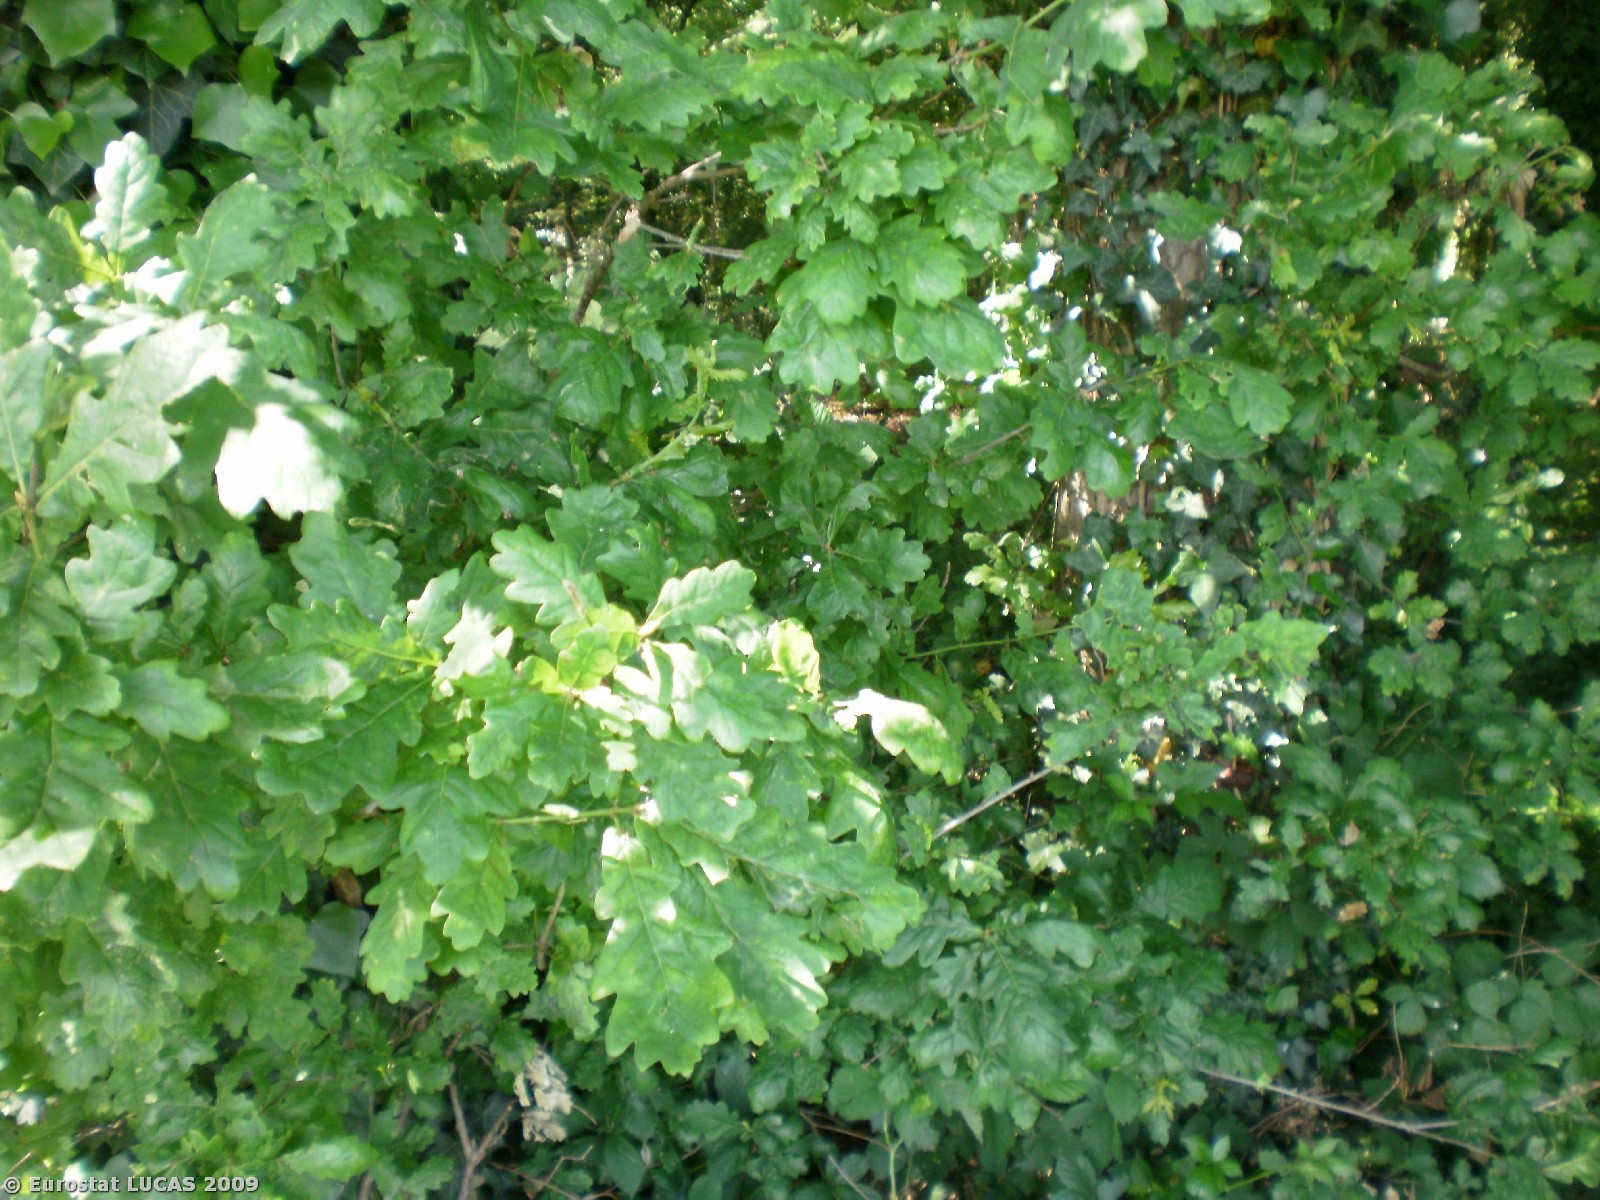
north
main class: Grassland
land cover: Grassland without tree/shrub cover
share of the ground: > 75 %
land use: Agriculture (excluding fallow land and kitchen gardens)
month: June
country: BE
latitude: 50.4684
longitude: 3.8368
